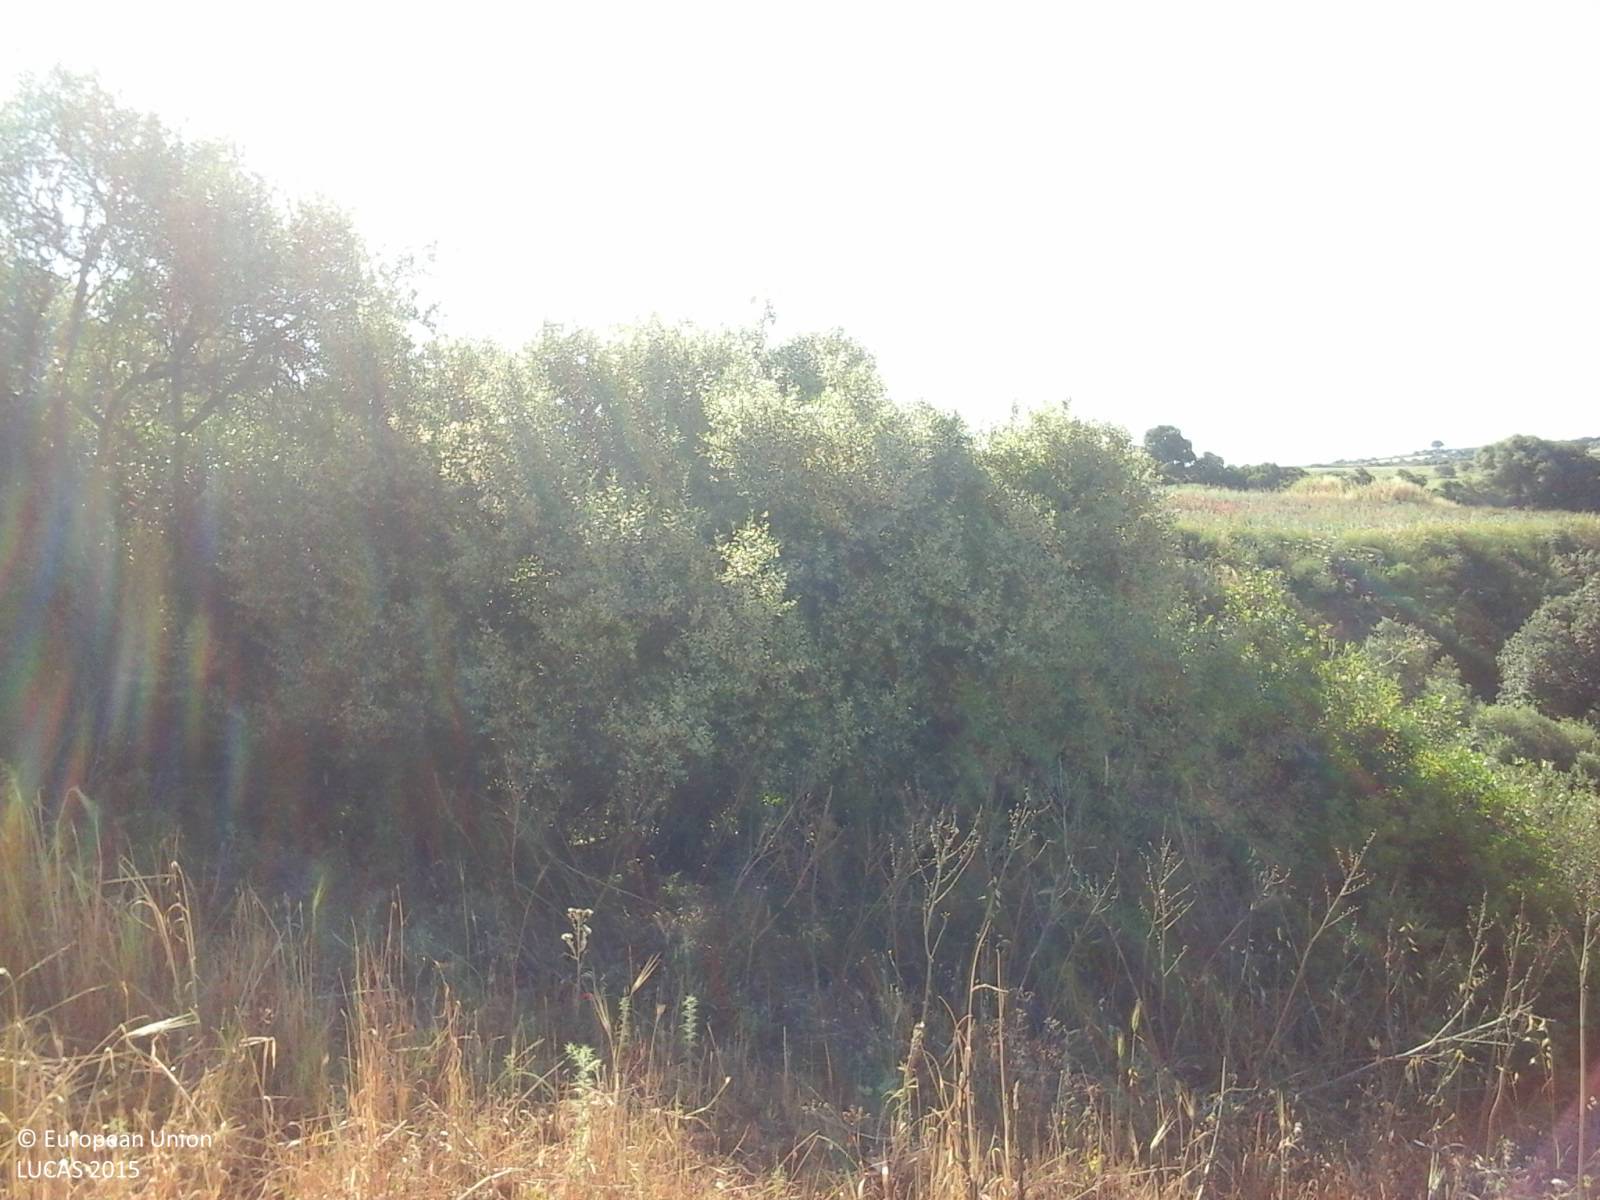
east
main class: Grassland
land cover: Grassland without tree/shrub cover
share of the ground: > 75 %
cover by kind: herbaceous plants 50 %
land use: Agriculture (excluding fallow land and kitchen gardens)
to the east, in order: Grassland without tree/shrub cover; Fences; Shrubland without tree cover; Grassland without tree/shrub cover; Abandoned hedges; Grassland without tree/shrub cover; Tracks; Shrubland with sparse tree cover; Olive groves; Fences; Dry stone walls; Conifer hedges; Paved roads, cycling and walking lanes; Abandoned hedges
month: May
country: IT
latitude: 40.6900
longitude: 8.4809
